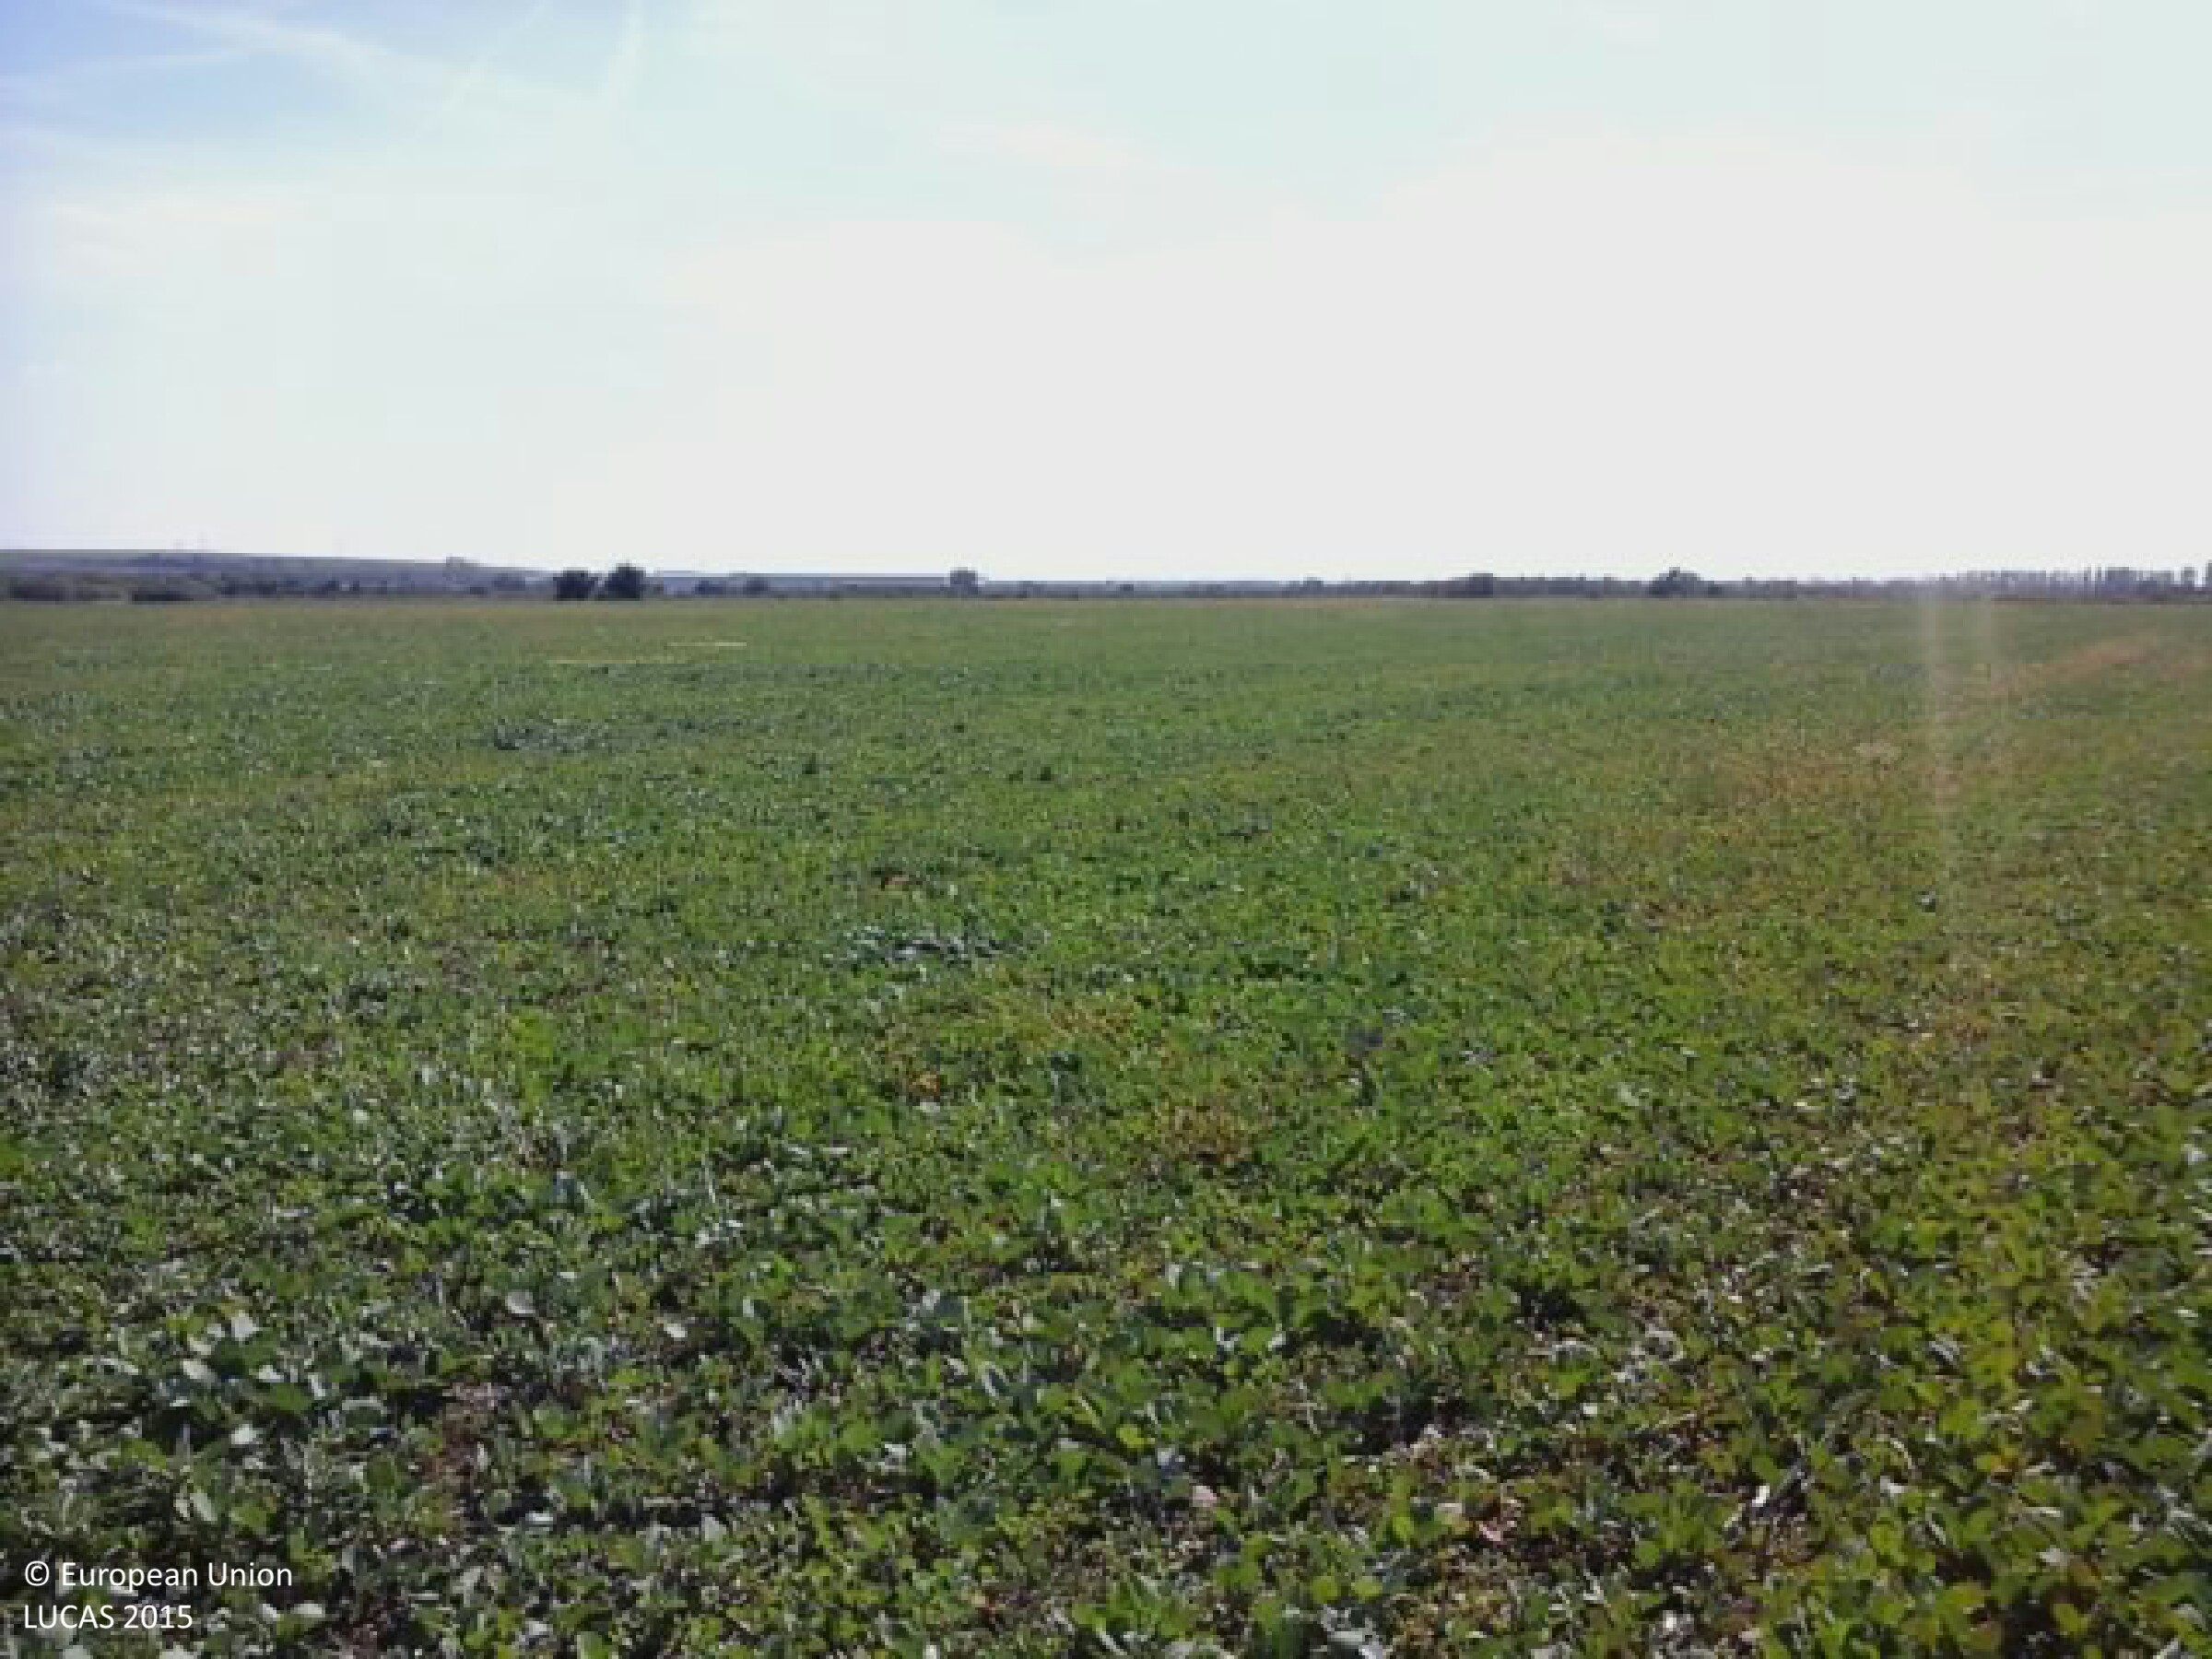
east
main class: Cropland
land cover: Rape and turnip rape
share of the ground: > 75 %
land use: Agriculture (excluding fallow land and kitchen gardens)
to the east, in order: Rape and turnip rape
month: September
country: HU
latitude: 47.7553
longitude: 19.9379
